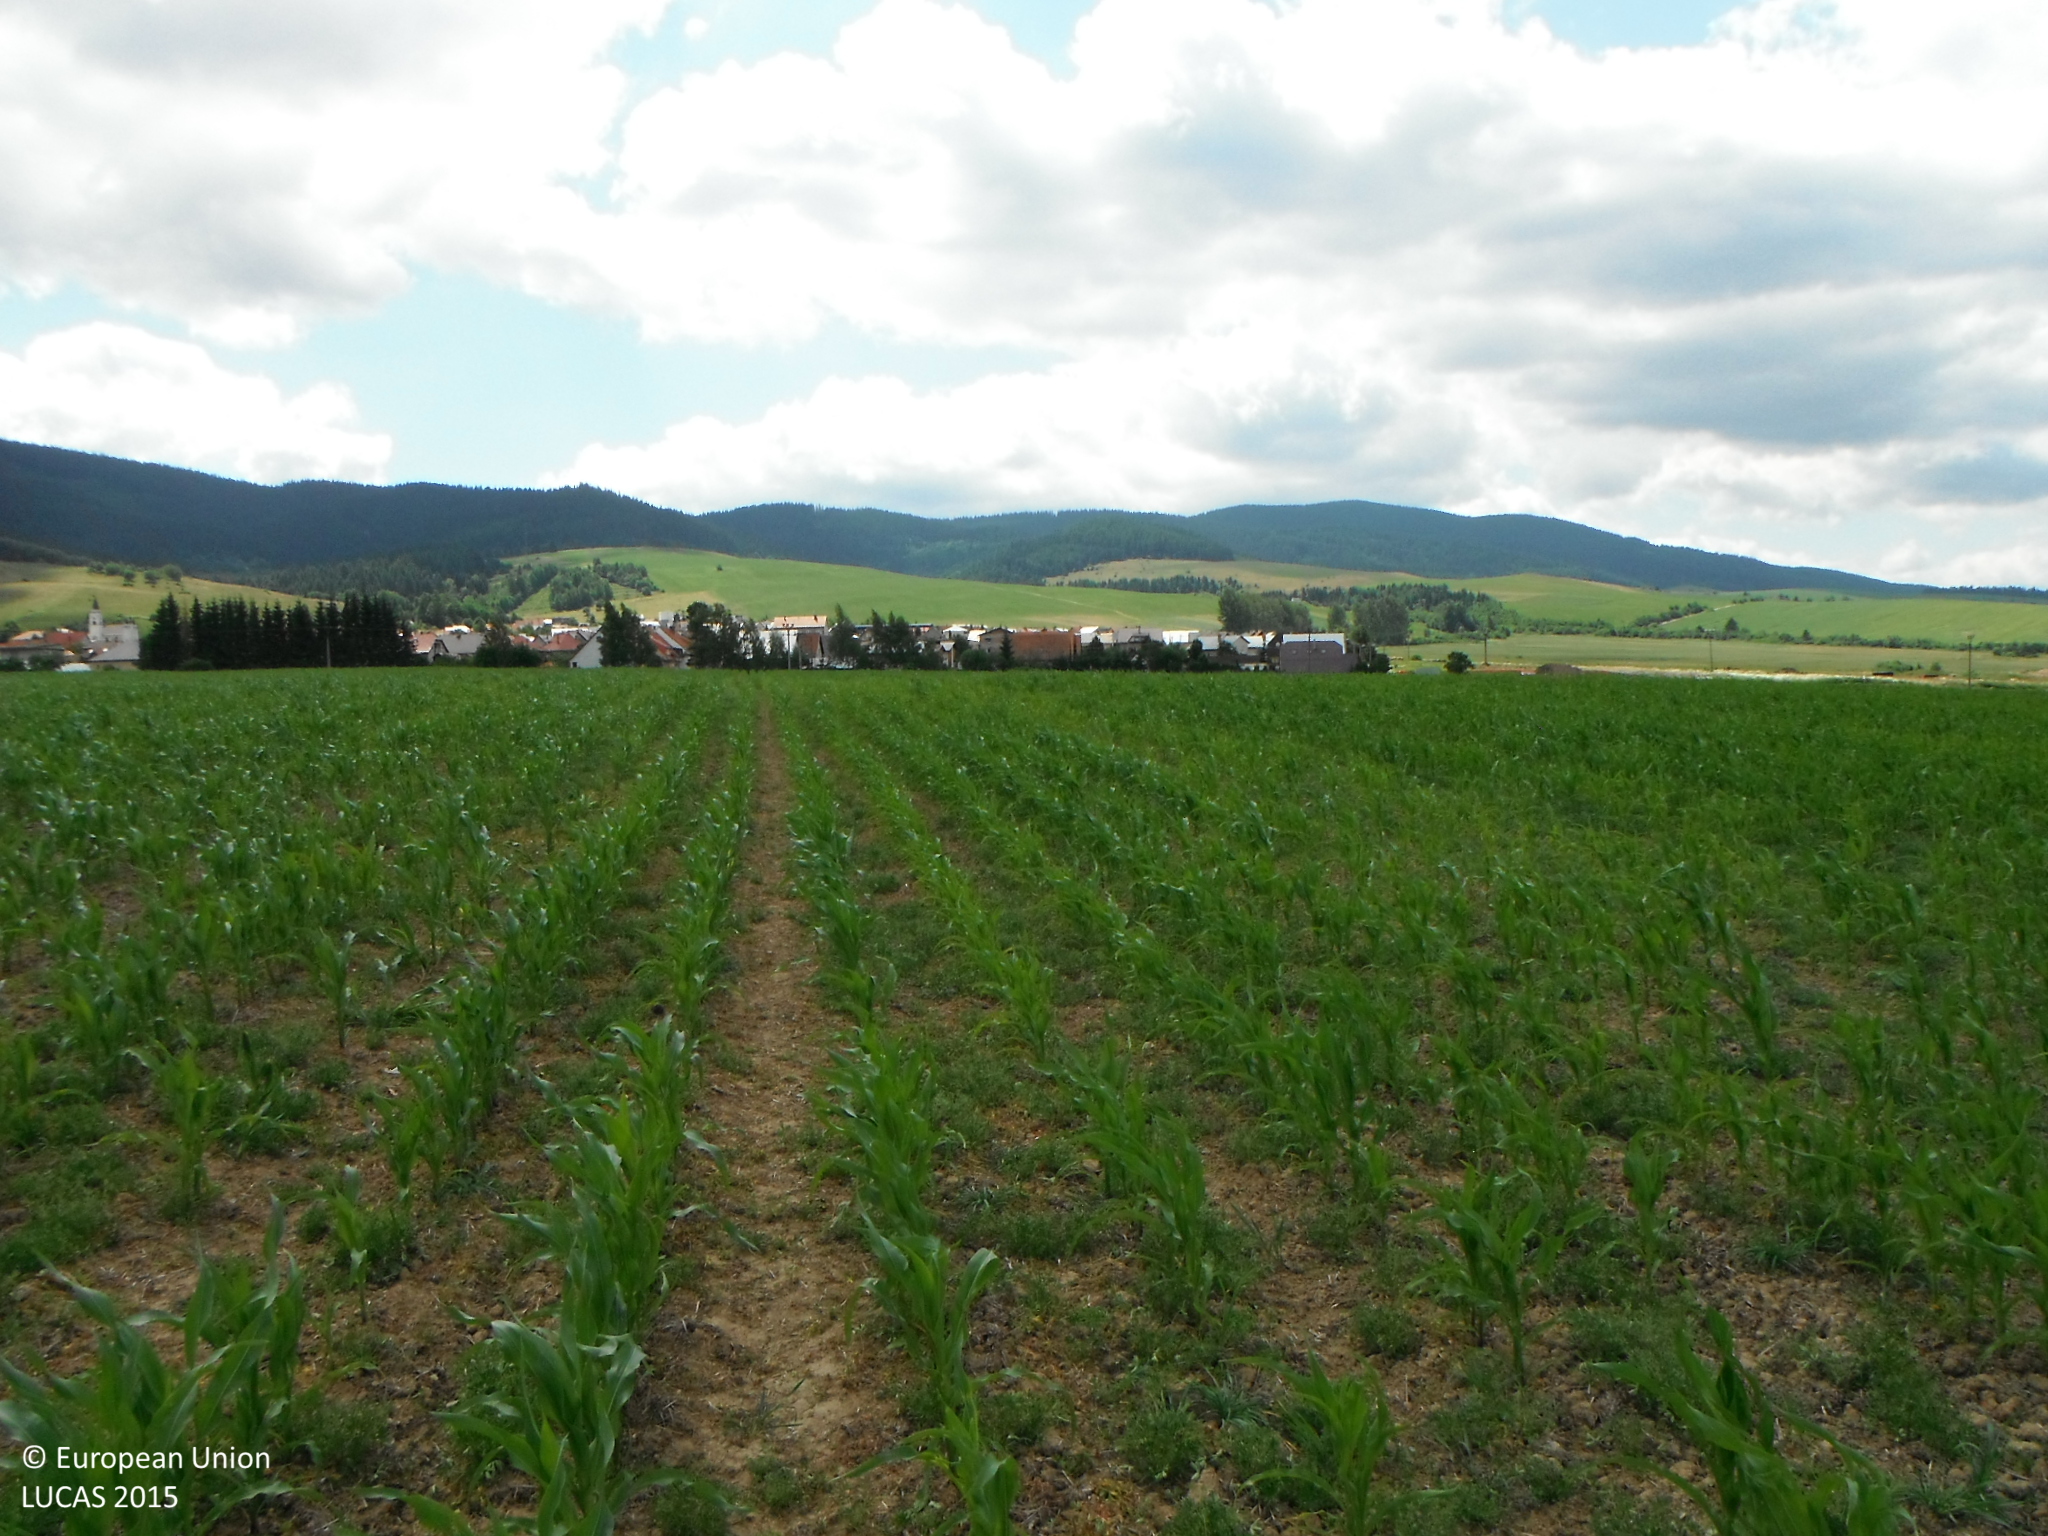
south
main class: Cropland
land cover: Maize
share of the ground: 25 - 50 %
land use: Agriculture (excluding fallow land and kitchen gardens)
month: July
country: SK
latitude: 49.3914
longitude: 19.4637
